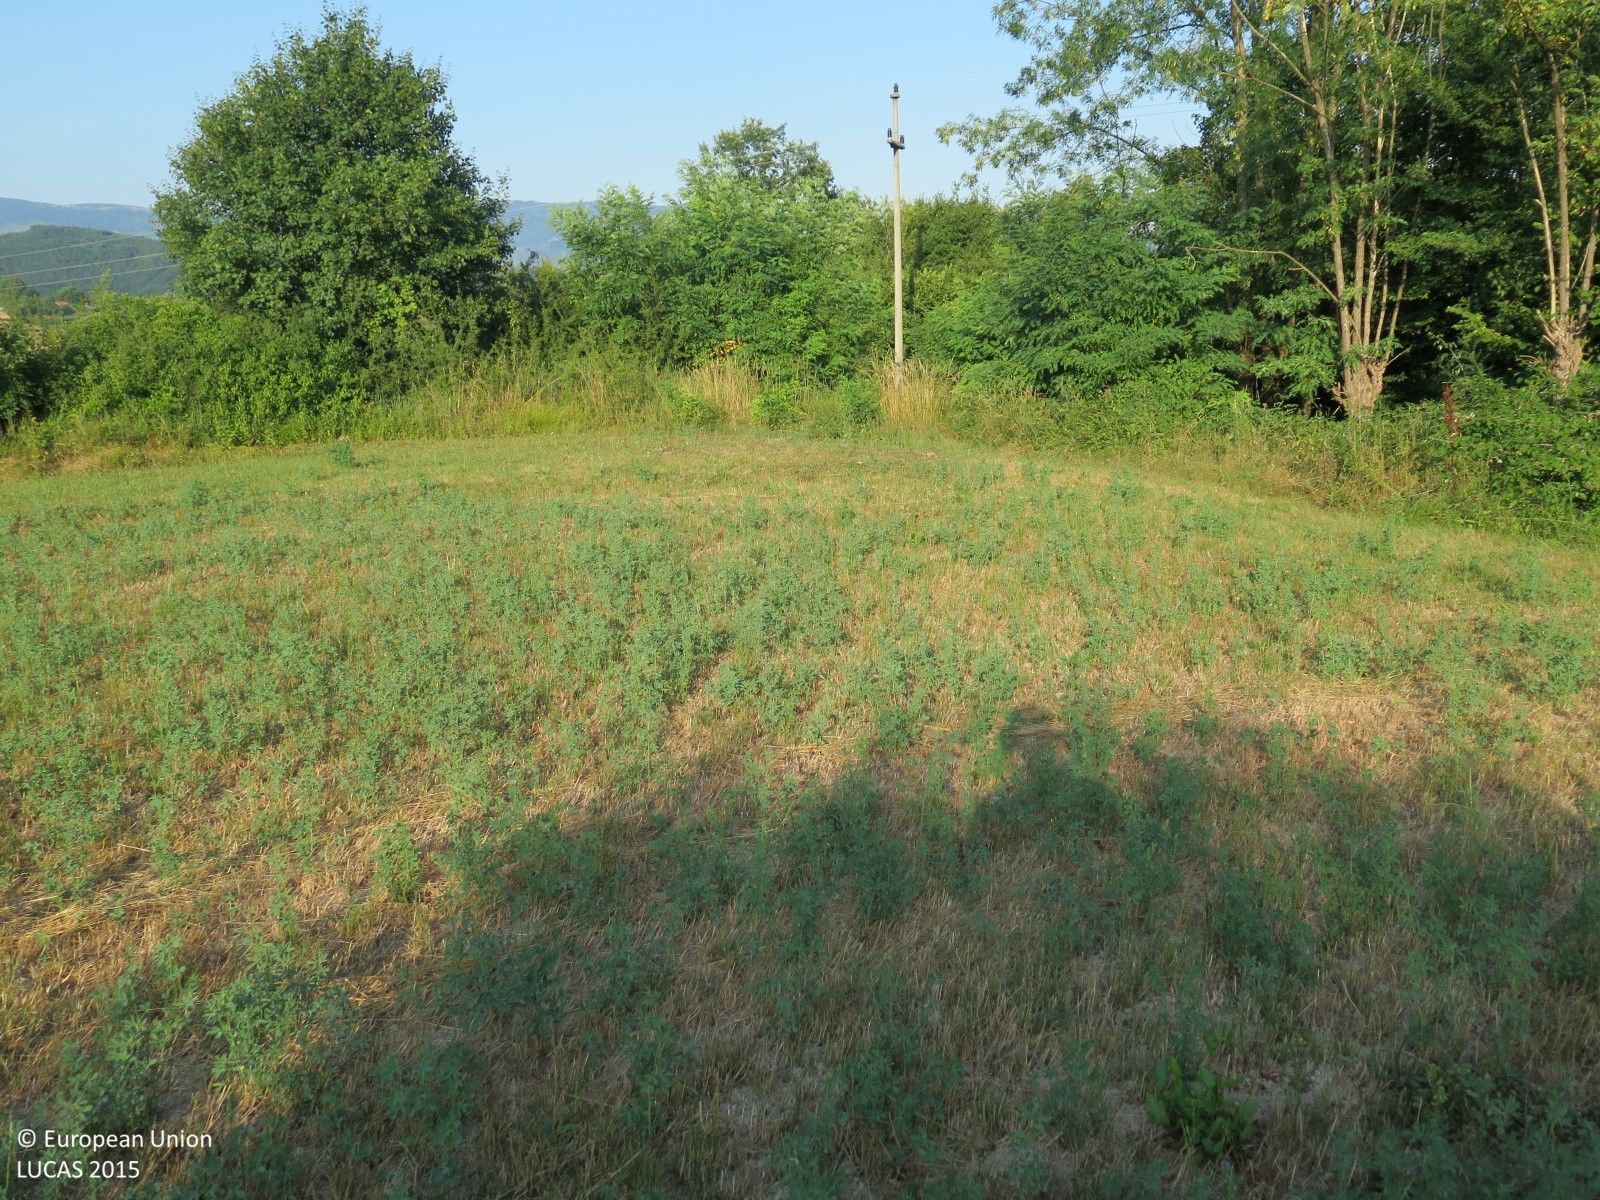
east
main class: Cropland
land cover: Lucerne
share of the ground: > 75 %
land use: Agriculture (excluding fallow land and kitchen gardens)
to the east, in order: Lucerne; Abandoned hedges; Electric lines; Olive groves; Abandoned hedges; Ditches and canals; Abandoned hedges; Grass margins; Paved roads, cycling and walking lanes; Grass margins; Electric lines; Shrubland with sparse tree cover; Grassland without tree/shrub cover; Lines of trees; Grassland without tree/shrub cover; Dry stone walls; Grassland without tree/shrub cover; Electric lines; Spontaneously vegetated surfaces; Abandoned hedges; Temporary grasslands; Grassland without tree/shrub cover
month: July
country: HR
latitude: 45.2100
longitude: 14.0564
